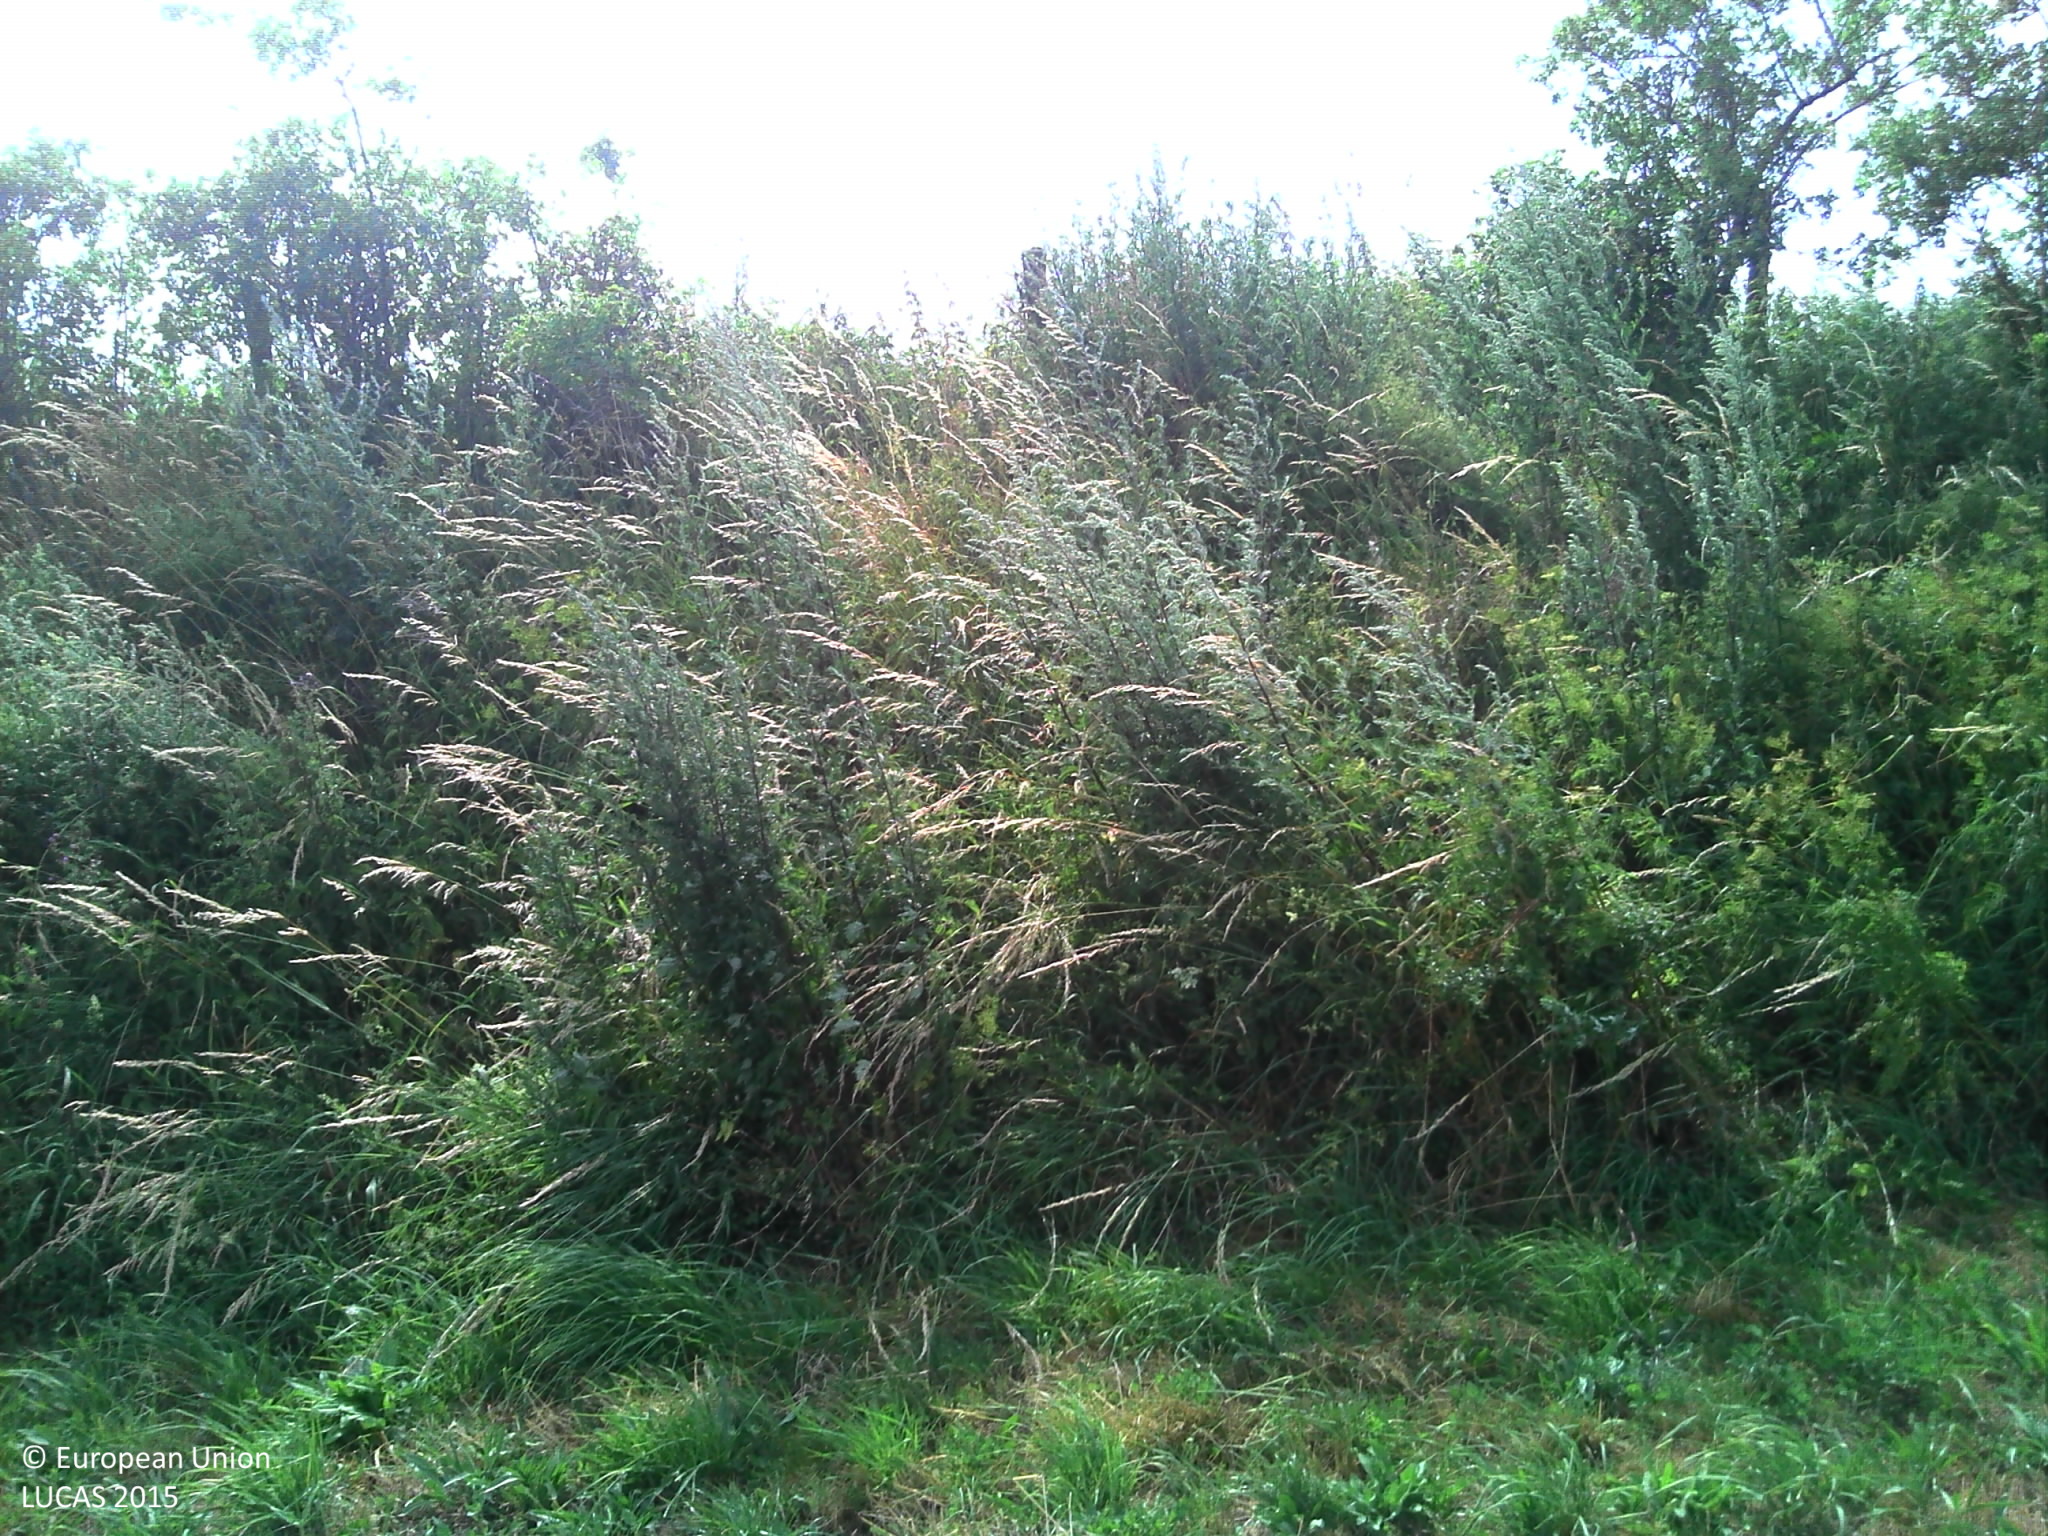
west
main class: Grassland
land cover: Grassland without tree/shrub cover
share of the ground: > 75 %
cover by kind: herbaceous plants 100 %
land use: Agriculture (excluding fallow land and kitchen gardens)
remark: Harvested field
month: July
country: FR
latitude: 44.8397
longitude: 3.8946
